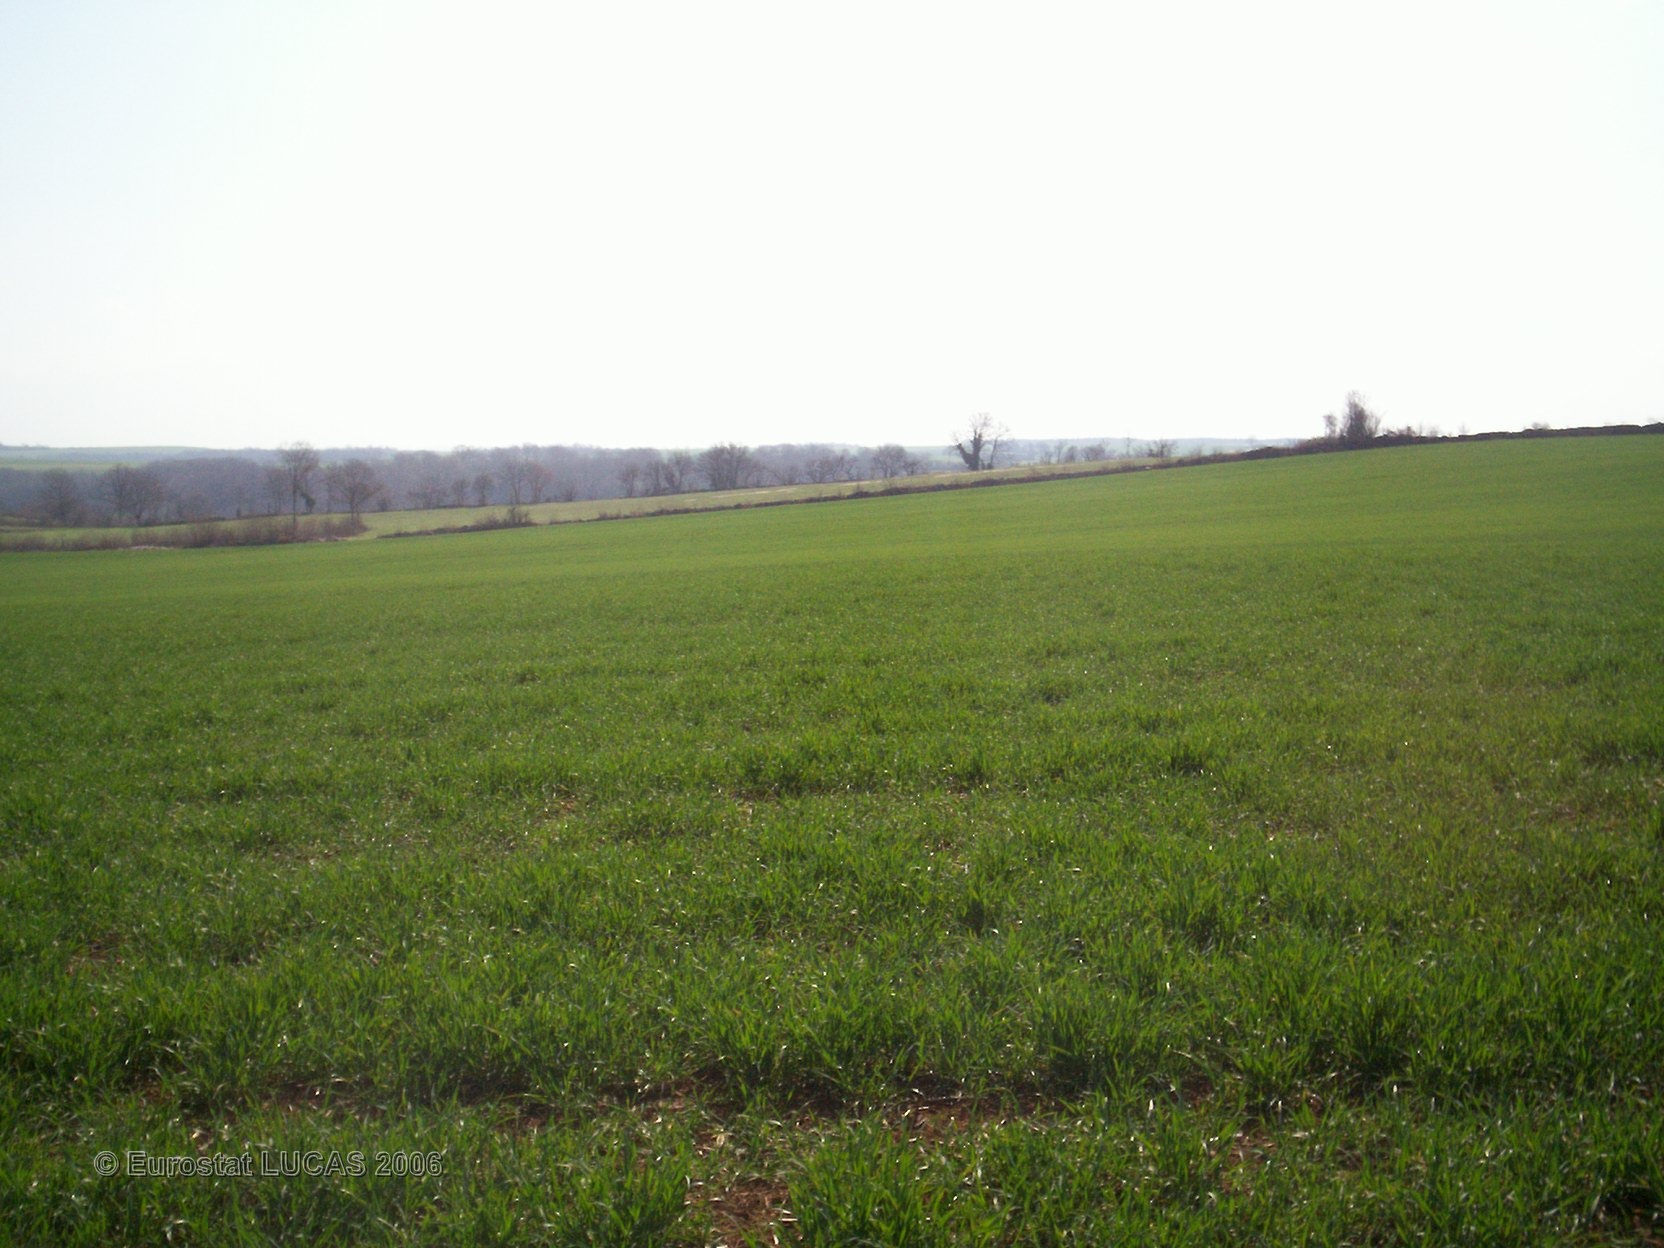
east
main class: Cropland
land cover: Common wheat
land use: Agriculture (excluding fallow land and kitchen gardens)
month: April
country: FR
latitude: 47.4394
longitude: 4.5495
